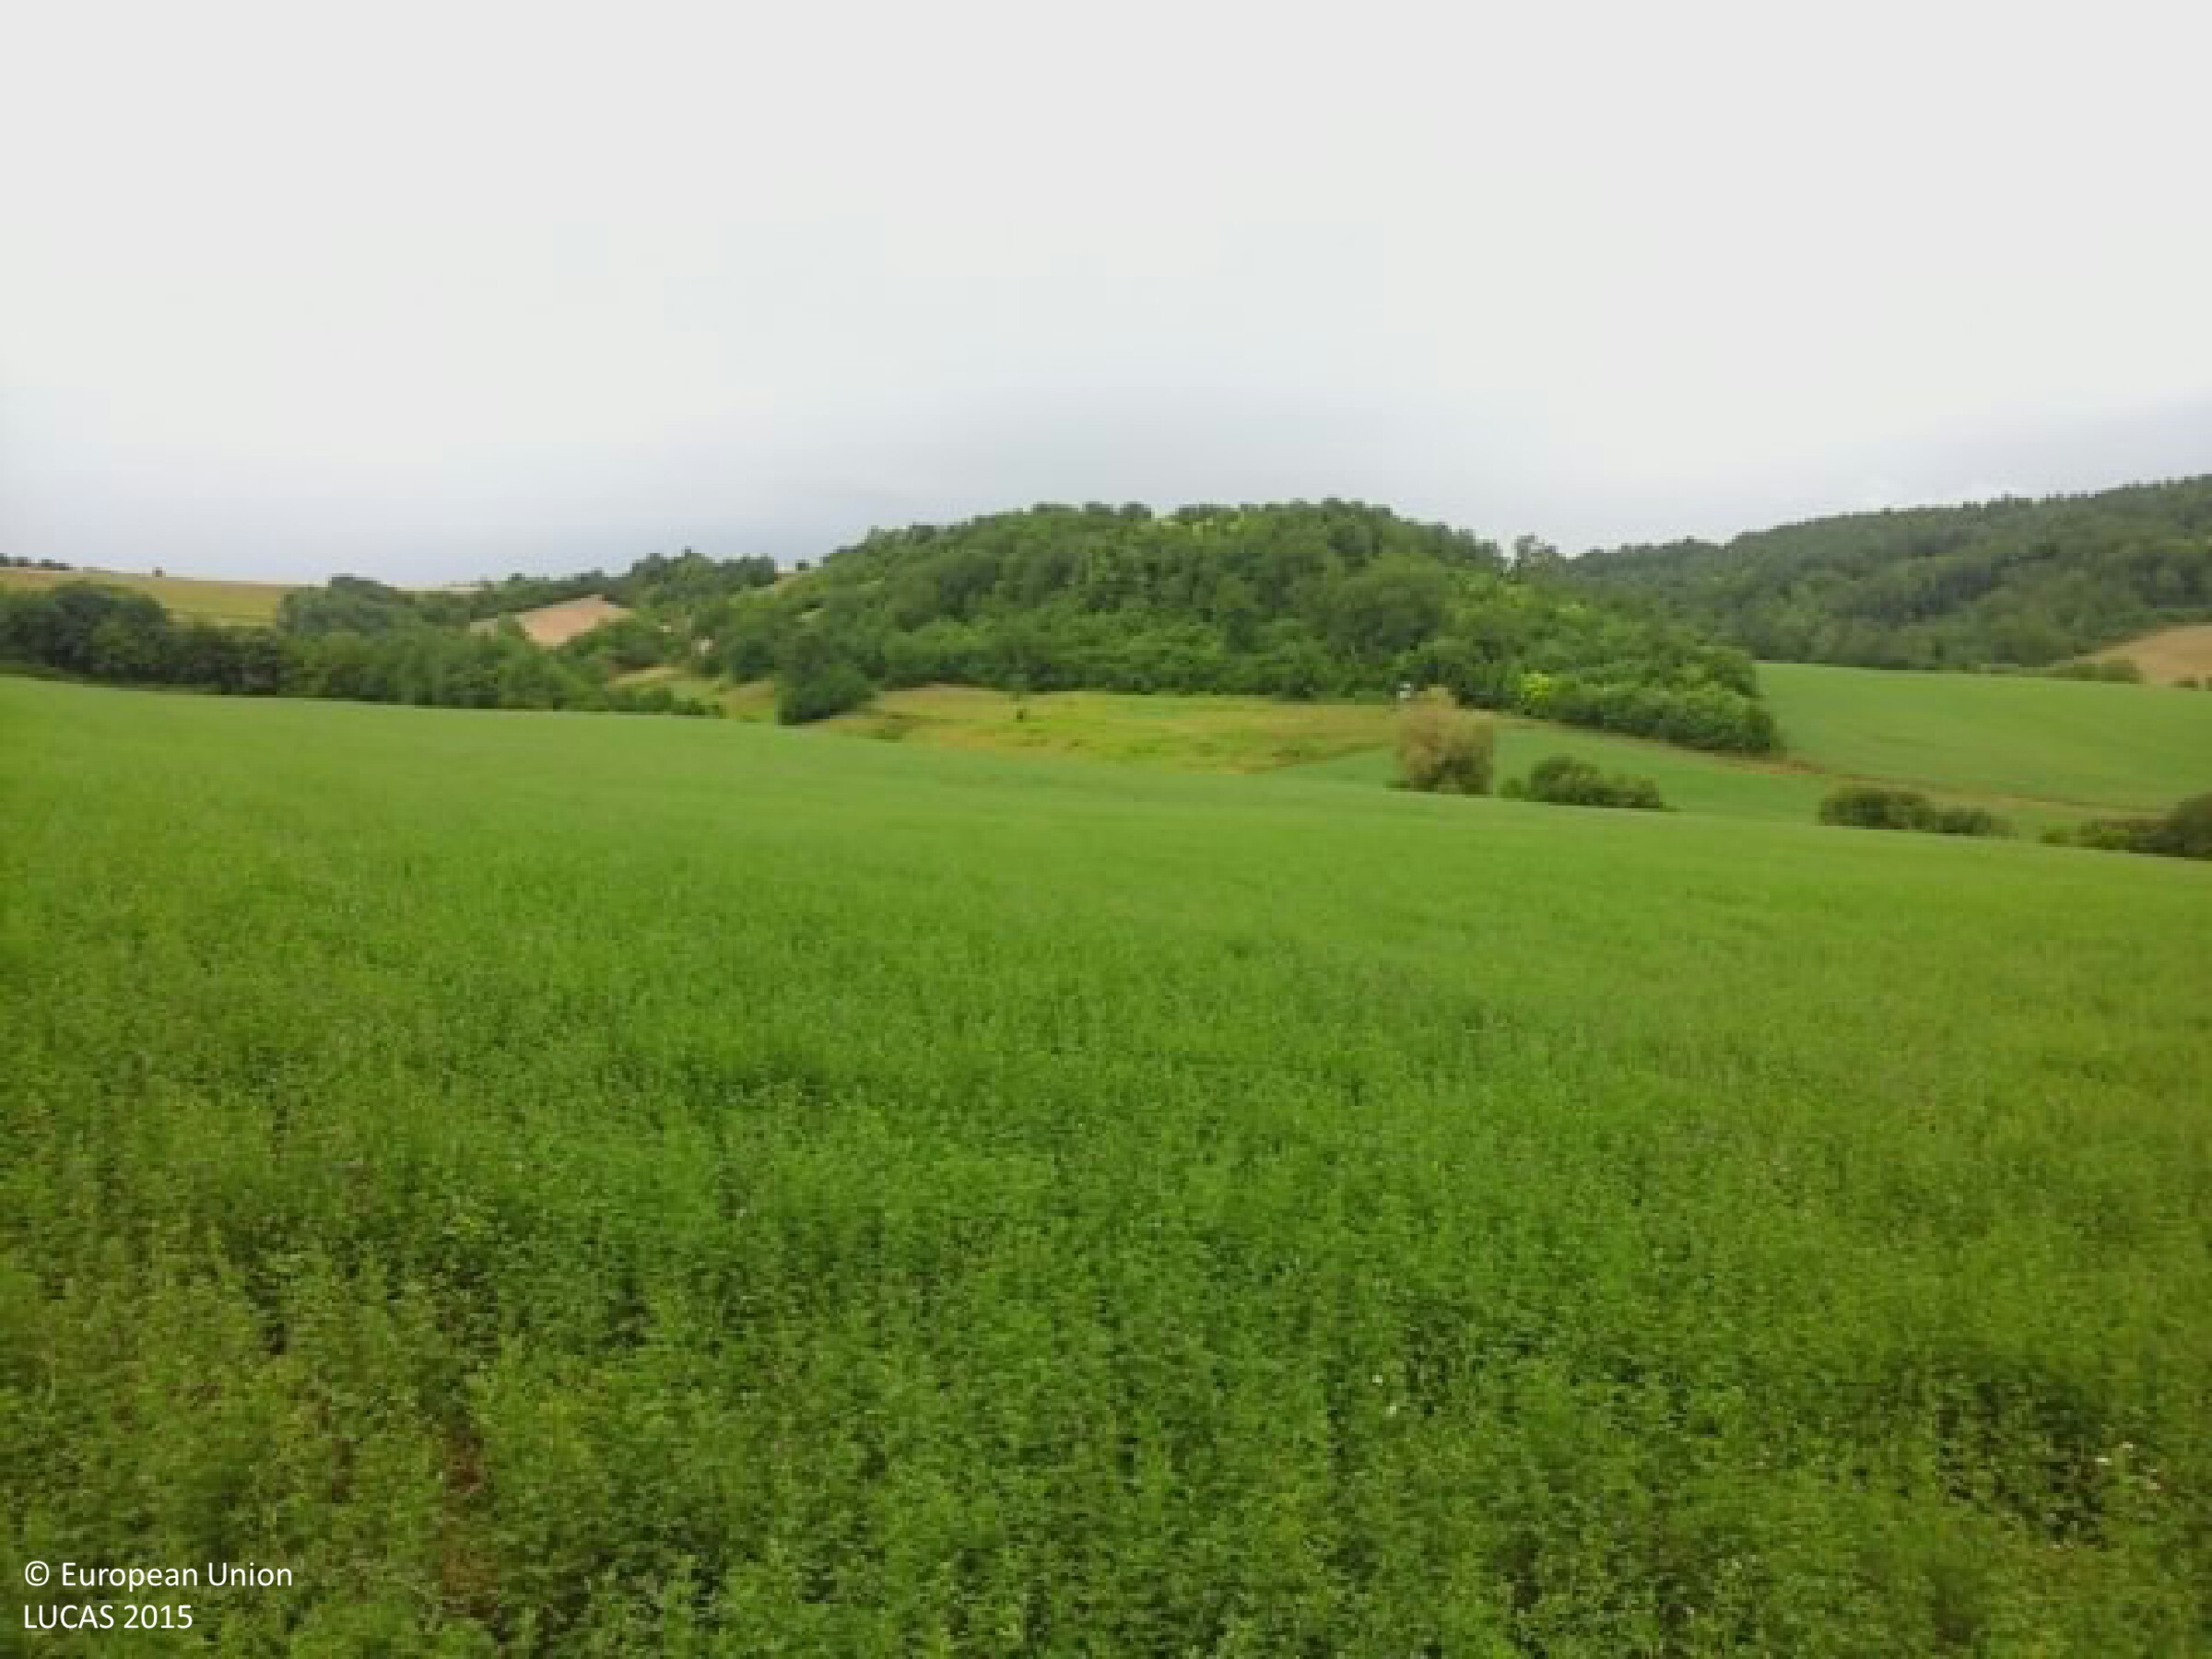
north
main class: Cropland
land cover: Lucerne
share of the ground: > 75 %
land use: Agriculture (excluding fallow land and kitchen gardens)
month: July
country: HU
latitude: 46.2297
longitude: 18.0327
